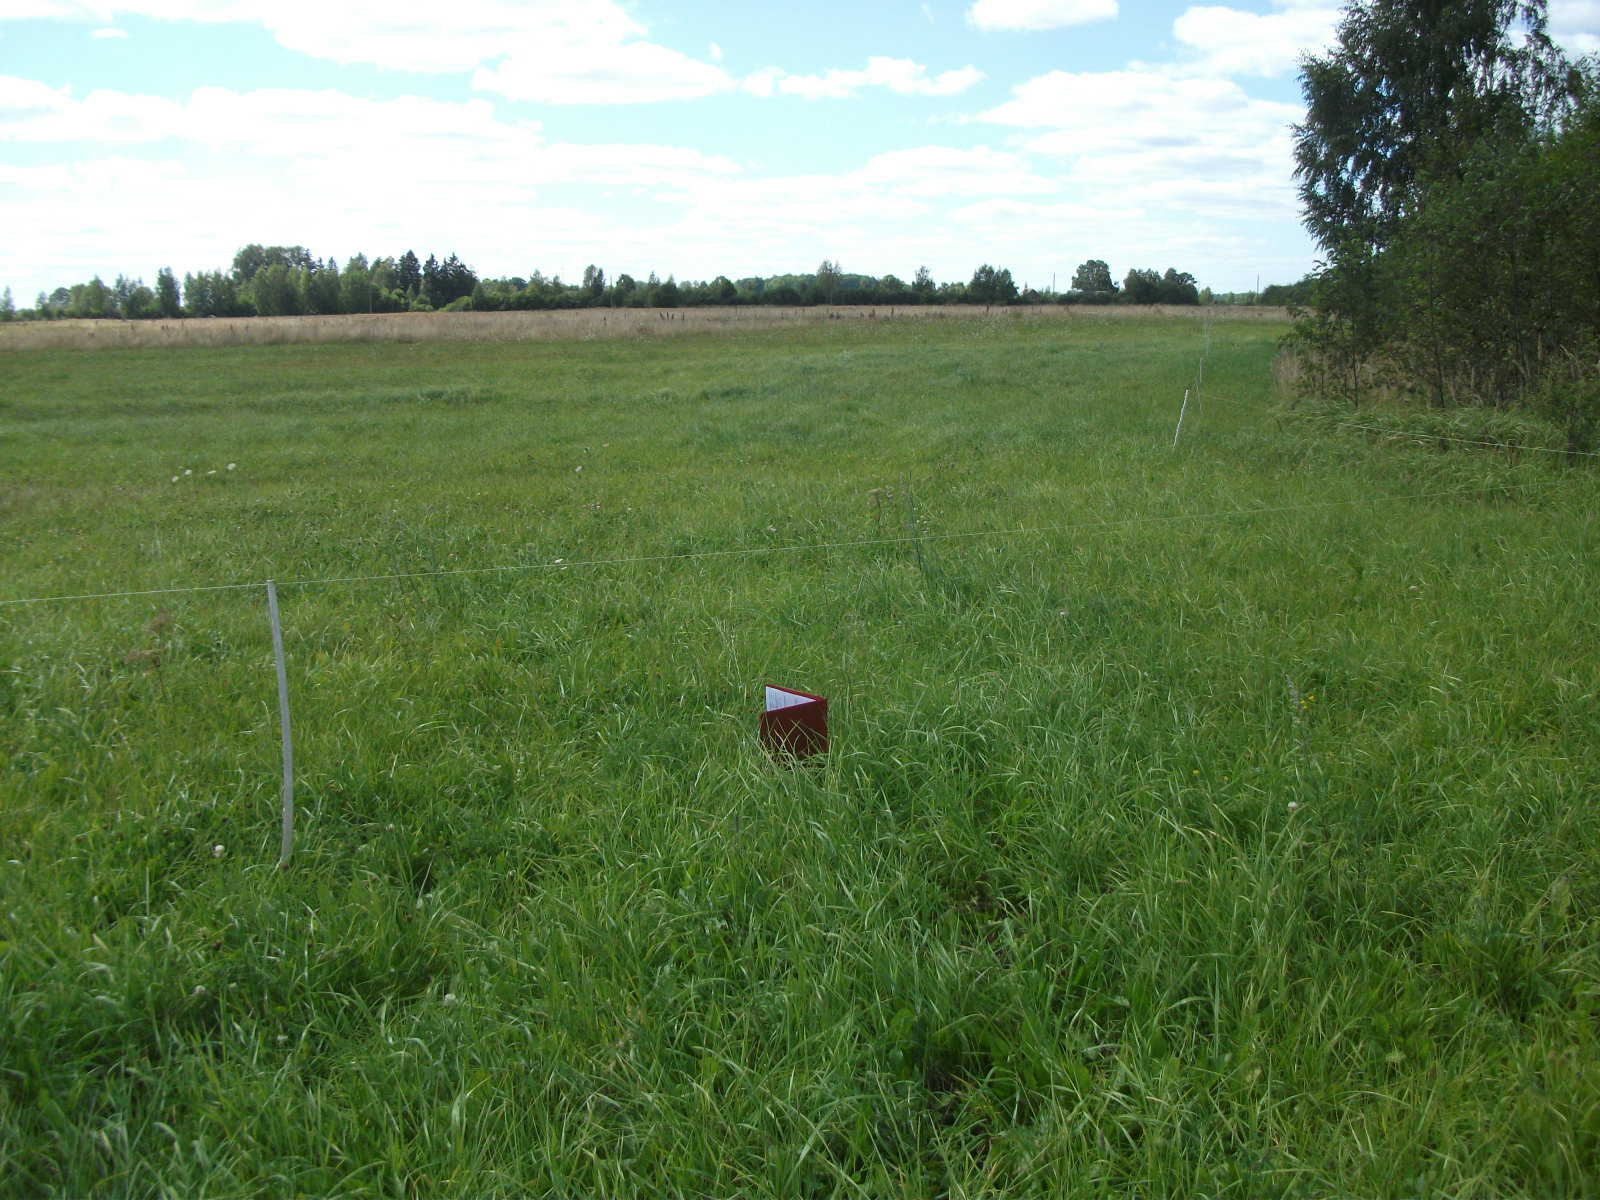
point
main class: Grassland
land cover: Grassland without tree/shrub cover
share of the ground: > 75 %
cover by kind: herbaceous plants 100 %
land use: Agriculture (excluding fallow land and kitchen gardens)
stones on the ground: < 10 %
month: August
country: LV
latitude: 56.5530
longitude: 26.4298
